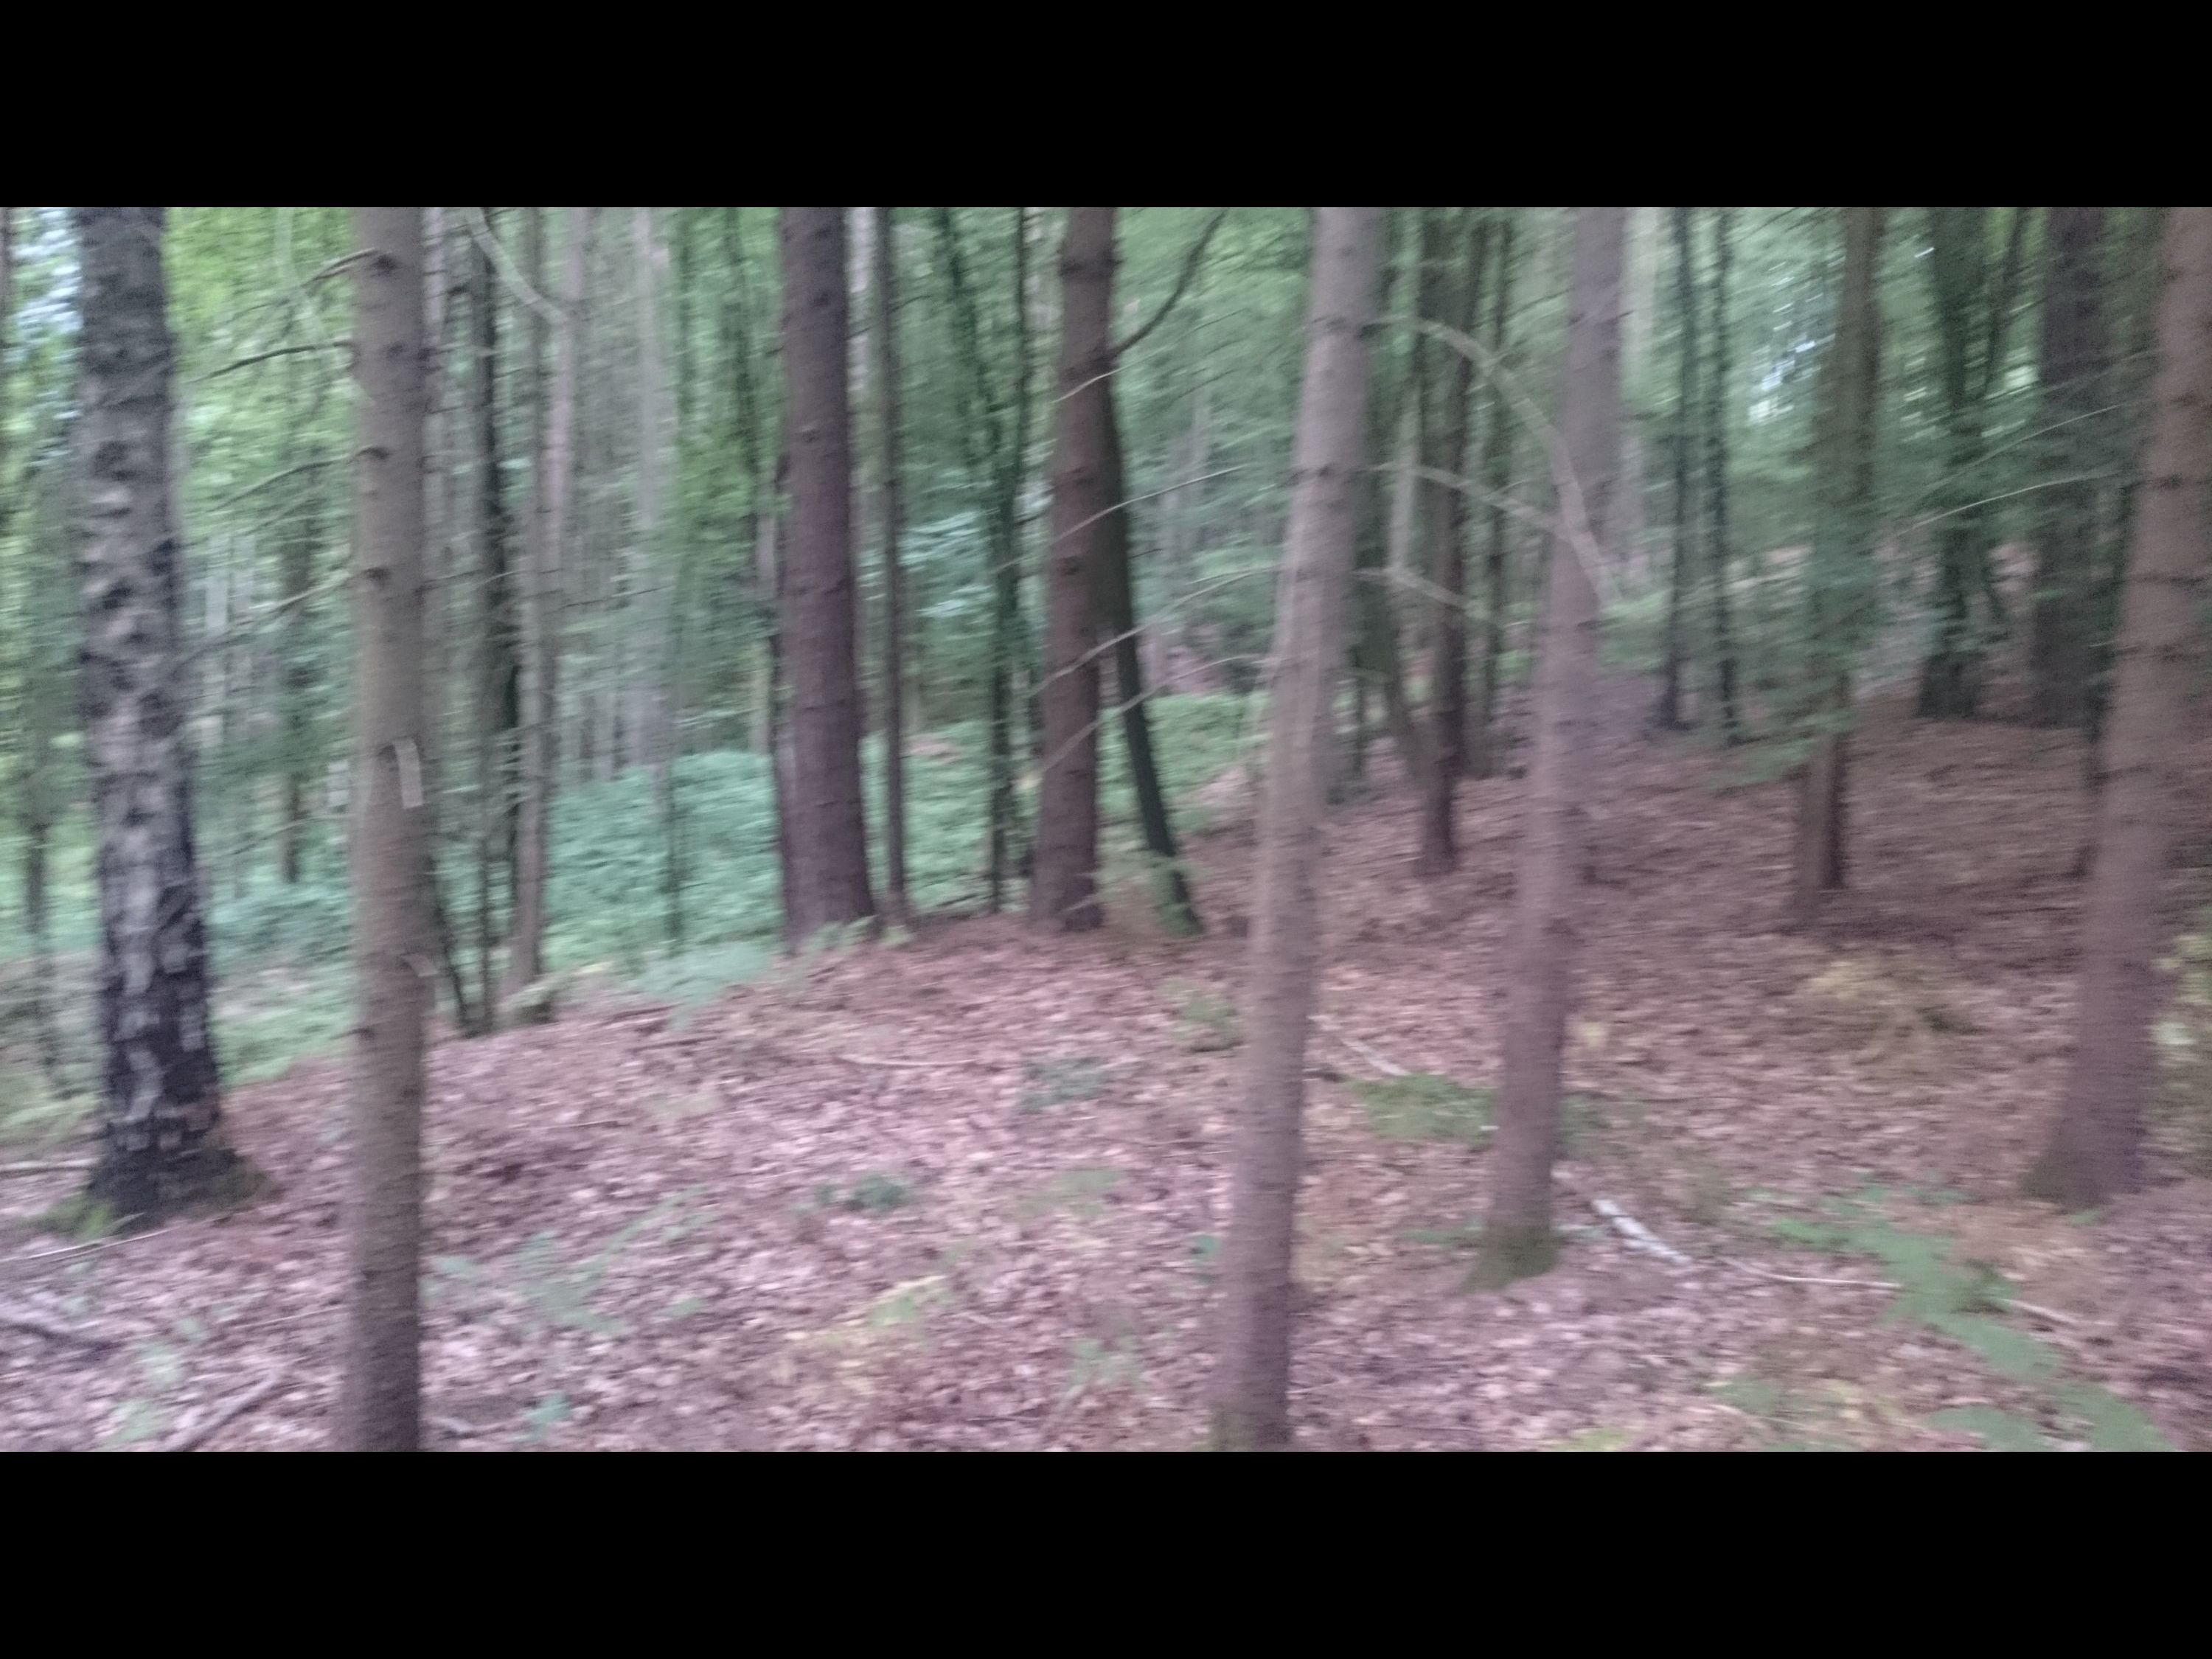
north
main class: Woodland
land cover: Other mixed woodland
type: hemiboreal forest and nemoral coniferous forest and mixed broadleaved-coniferous forest
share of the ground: > 75 %
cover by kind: coniferous forest trees 60 %, broadleaved forest trees 30 %, unconsolidated bare surface 10 %
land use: Forestry
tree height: > 5 m
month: July
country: AT
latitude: 46.9962
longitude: 15.9843
